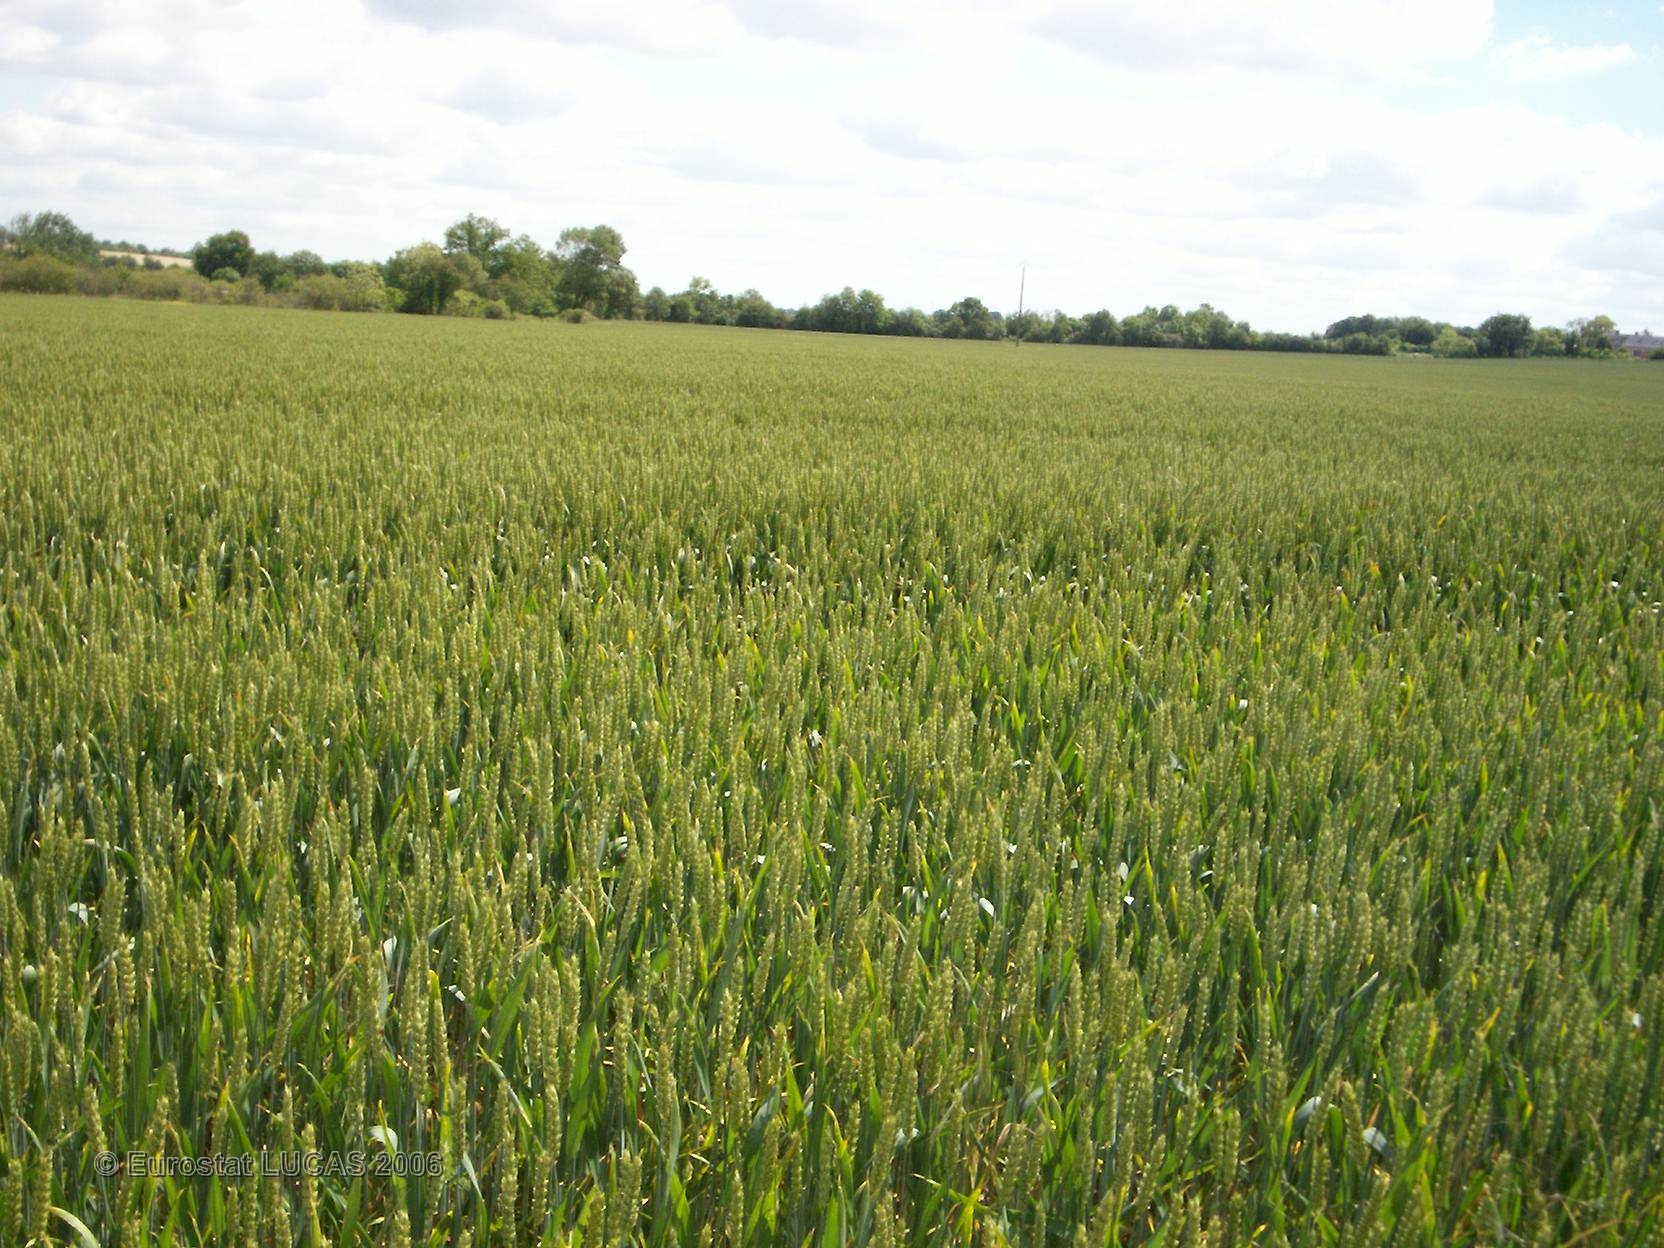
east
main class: Cropland
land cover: Common wheat
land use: Agriculture (excluding fallow land and kitchen gardens)
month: May
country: FR
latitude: 47.4954
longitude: -1.1219
